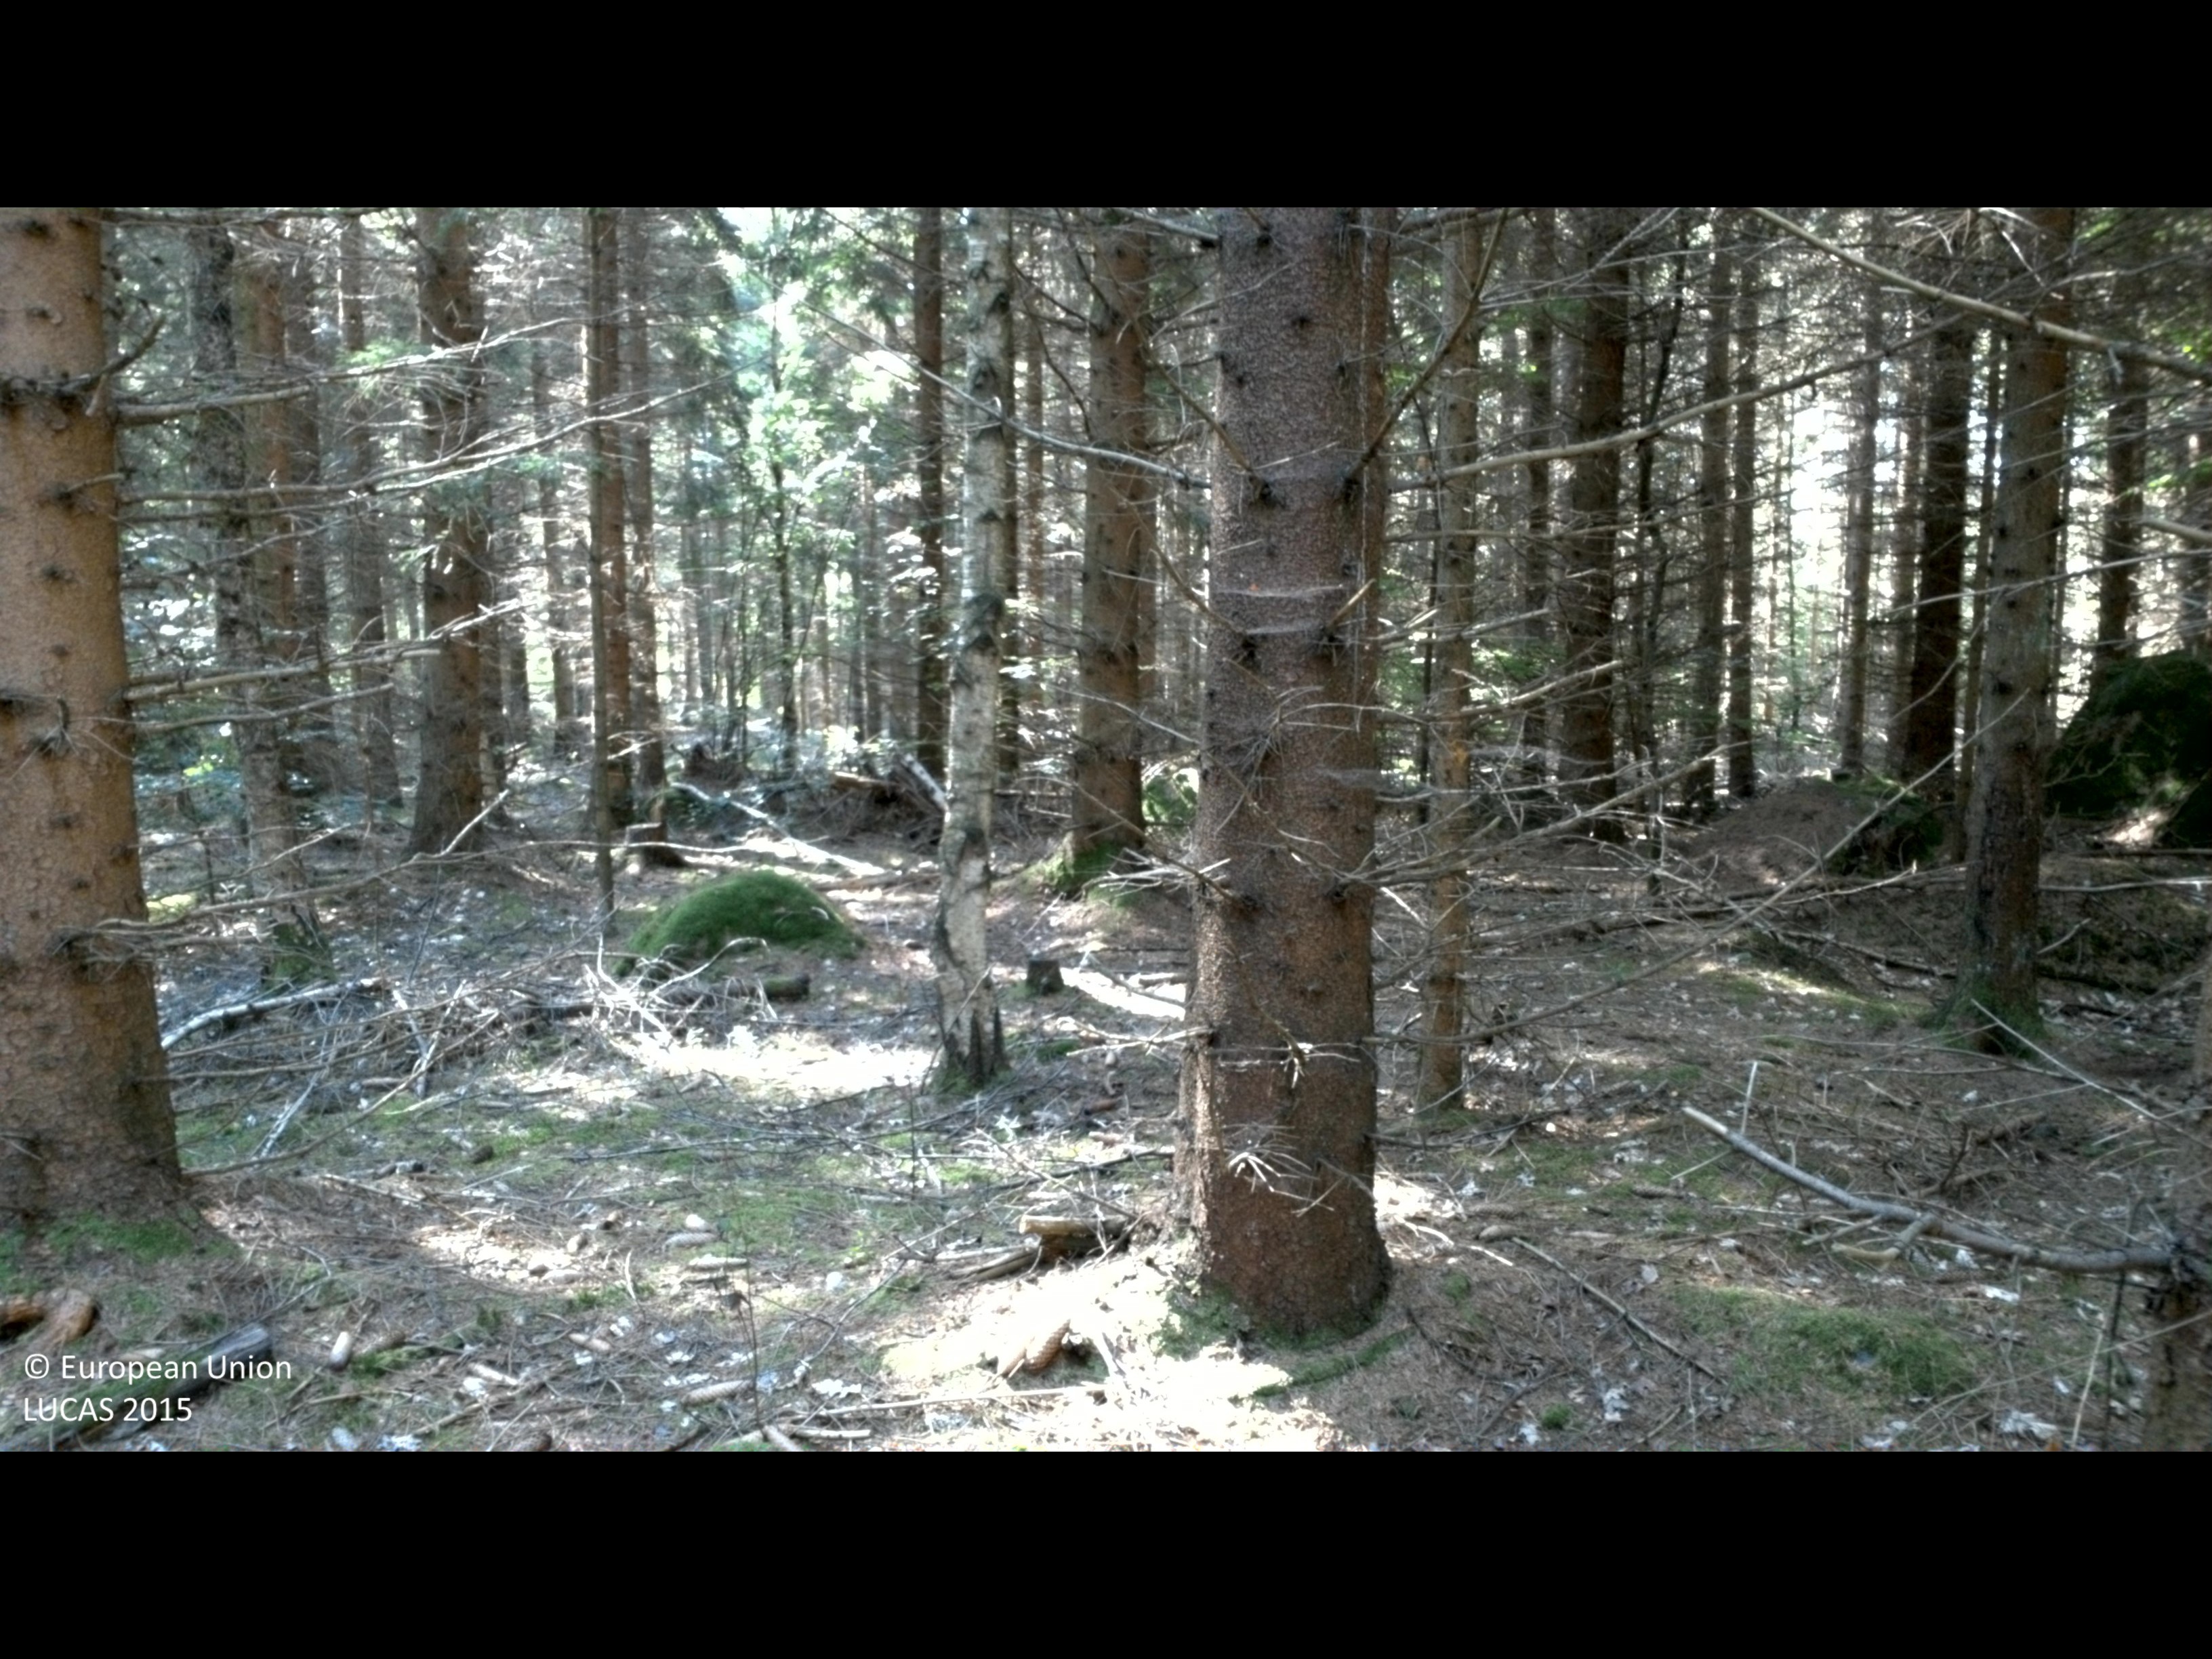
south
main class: Woodland
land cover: Spruce dominated coniferous woodland
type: boreal forest
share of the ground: > 75 %
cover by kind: coniferous forest trees 75 %, lichens and mosses 10 %, broadleaved forest trees 5 %, shrubs 5 %, herbaceous plants 5 %
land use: Forestry
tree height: > 5 m
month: August
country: SE
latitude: 56.2508
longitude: 15.8914
